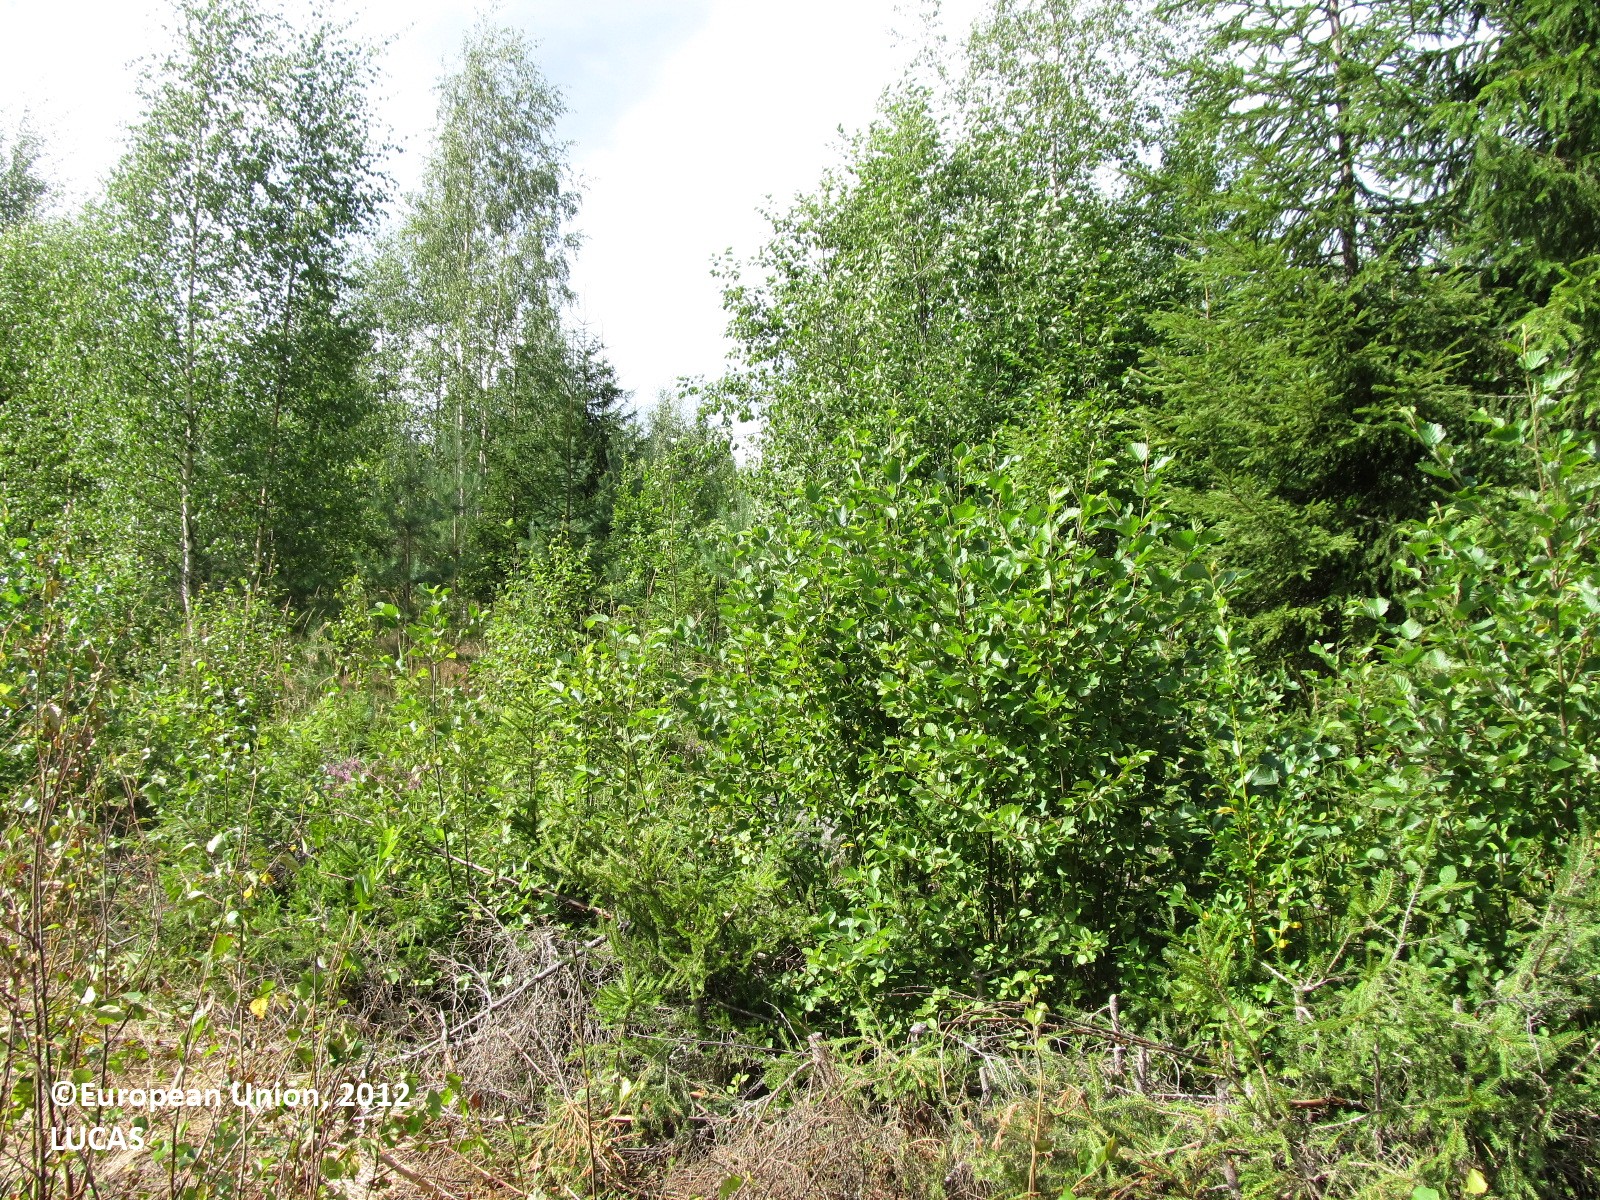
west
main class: Woodland
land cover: Pine dominated mixed woodland
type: boreal forest
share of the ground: 50 - 75 %
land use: Forestry
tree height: < 5 m
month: August
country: FI
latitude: 61.6874
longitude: 27.9378
